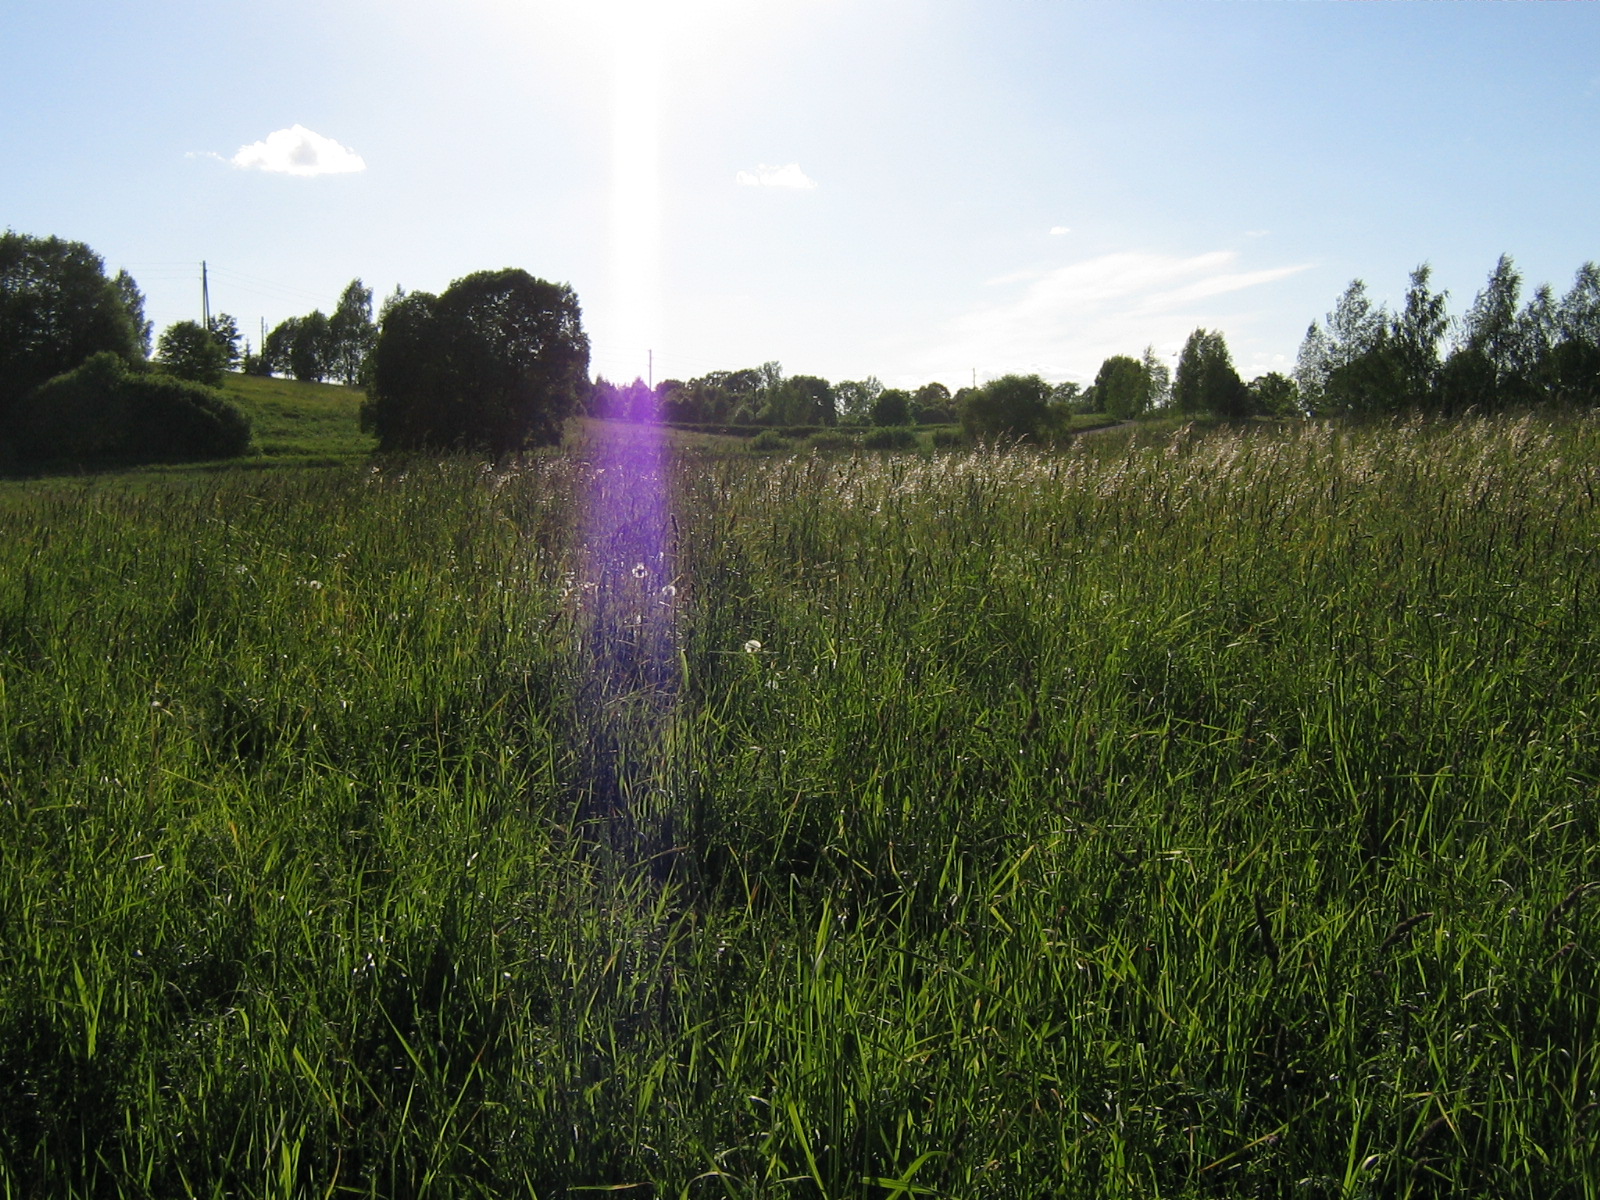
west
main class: Grassland
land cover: Grassland without tree/shrub cover
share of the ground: > 75 %
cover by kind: herbaceous plants 100 %
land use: Agriculture (excluding fallow land and kitchen gardens)
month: June
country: LV
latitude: 57.1555
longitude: 25.8818
